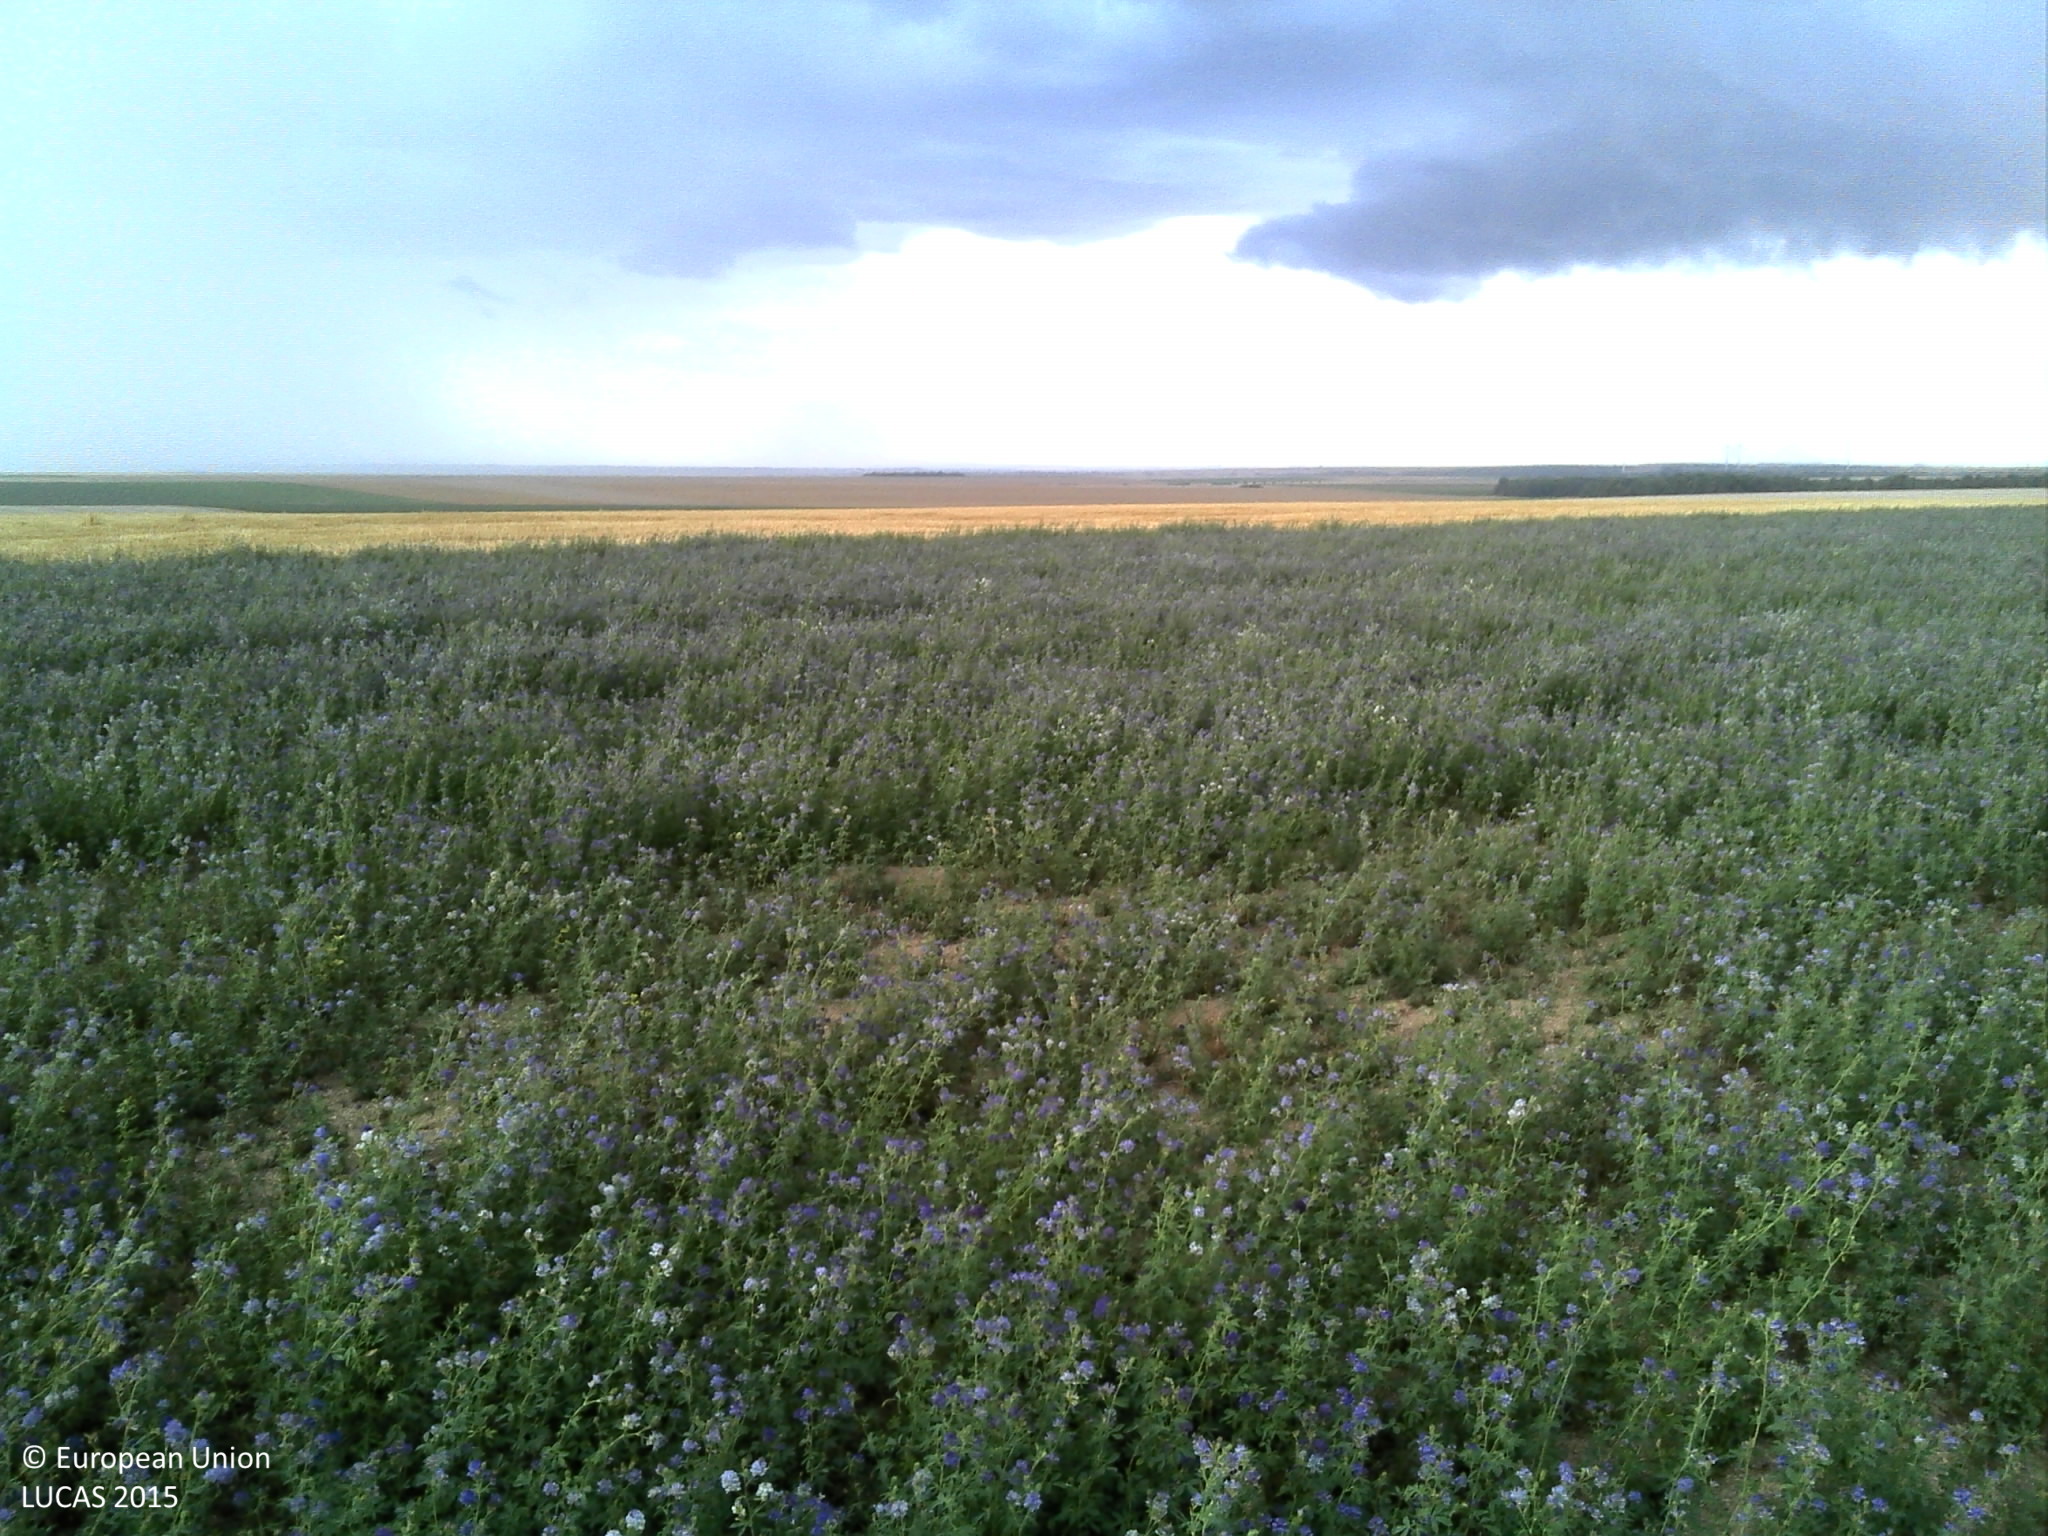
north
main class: Cropland
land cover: Lucerne
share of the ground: > 75 %
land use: Agriculture (excluding fallow land and kitchen gardens)
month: August
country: FR
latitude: 48.7985
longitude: 4.3194
